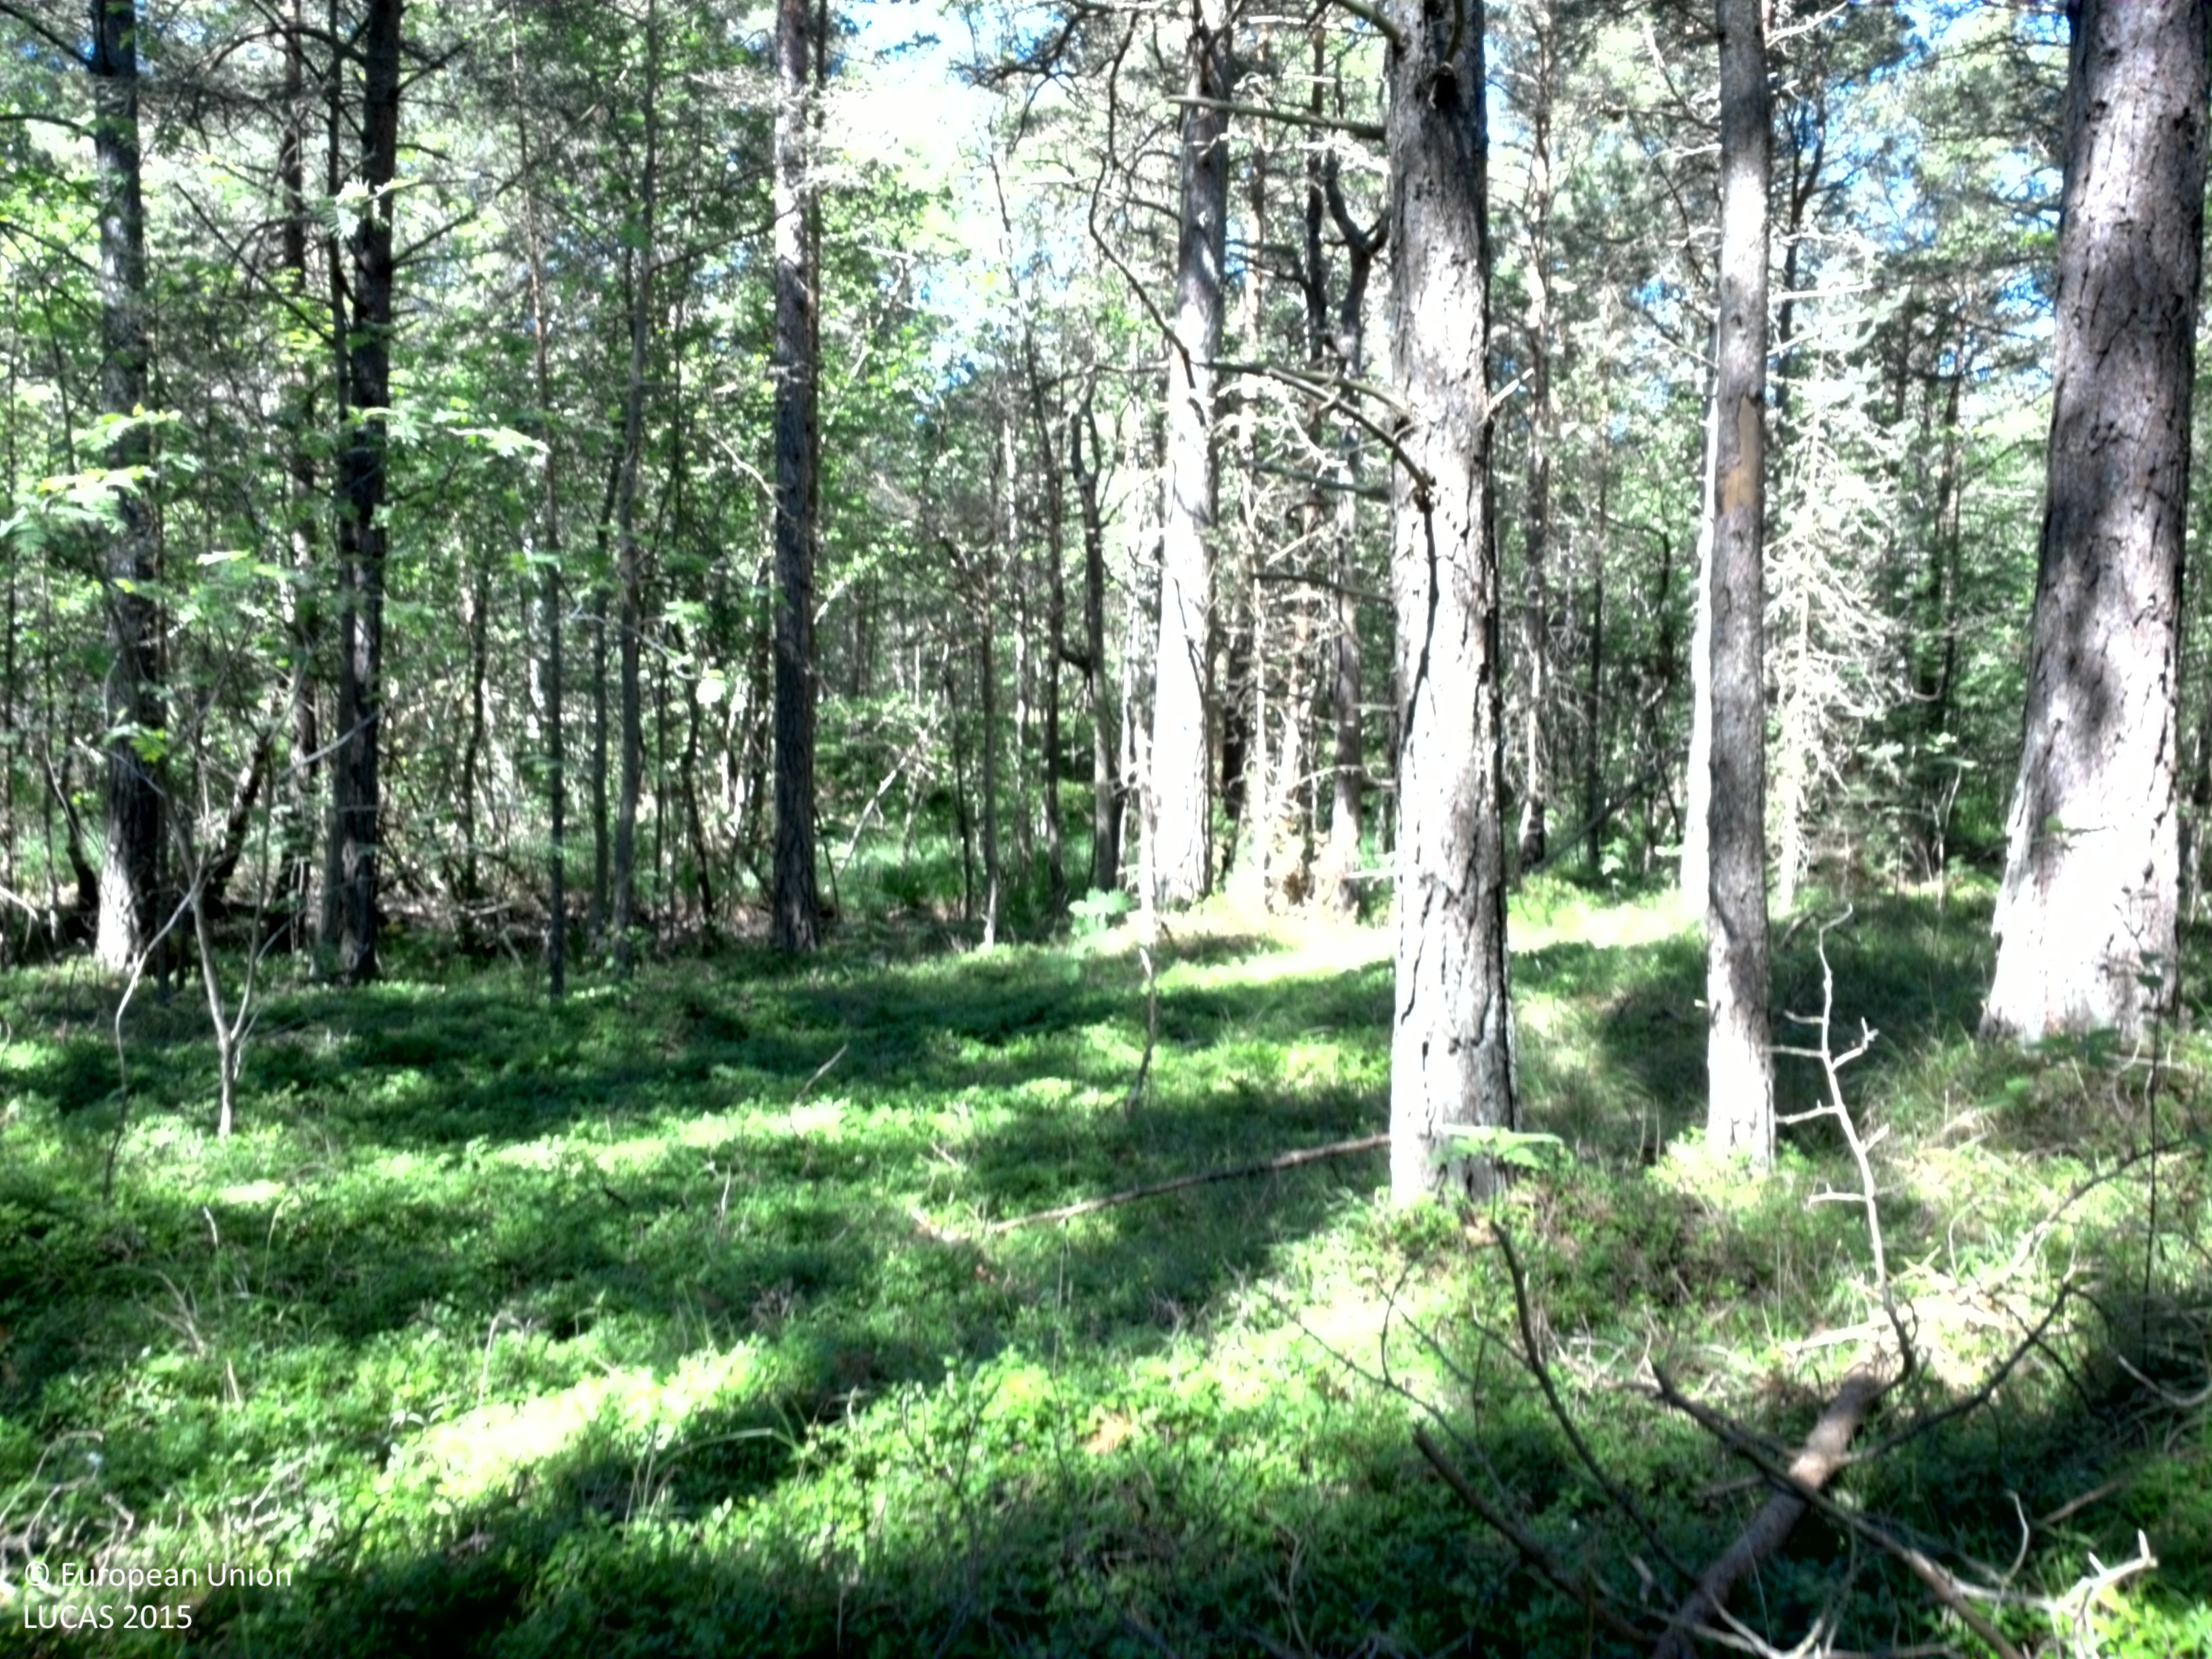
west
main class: Woodland
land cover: Pine dominated mixed woodland
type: hemiboreal forest and nemoral coniferous forest and mixed broadleaved-coniferous forest
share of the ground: > 75 %
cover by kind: coniferous forest trees 55 %, broadleaved forest trees 25 %, herbaceous plants 15 %, shrubs 5 %
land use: Forestry
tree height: > 5 m
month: July
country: SE
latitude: 57.9672
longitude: 19.3268
